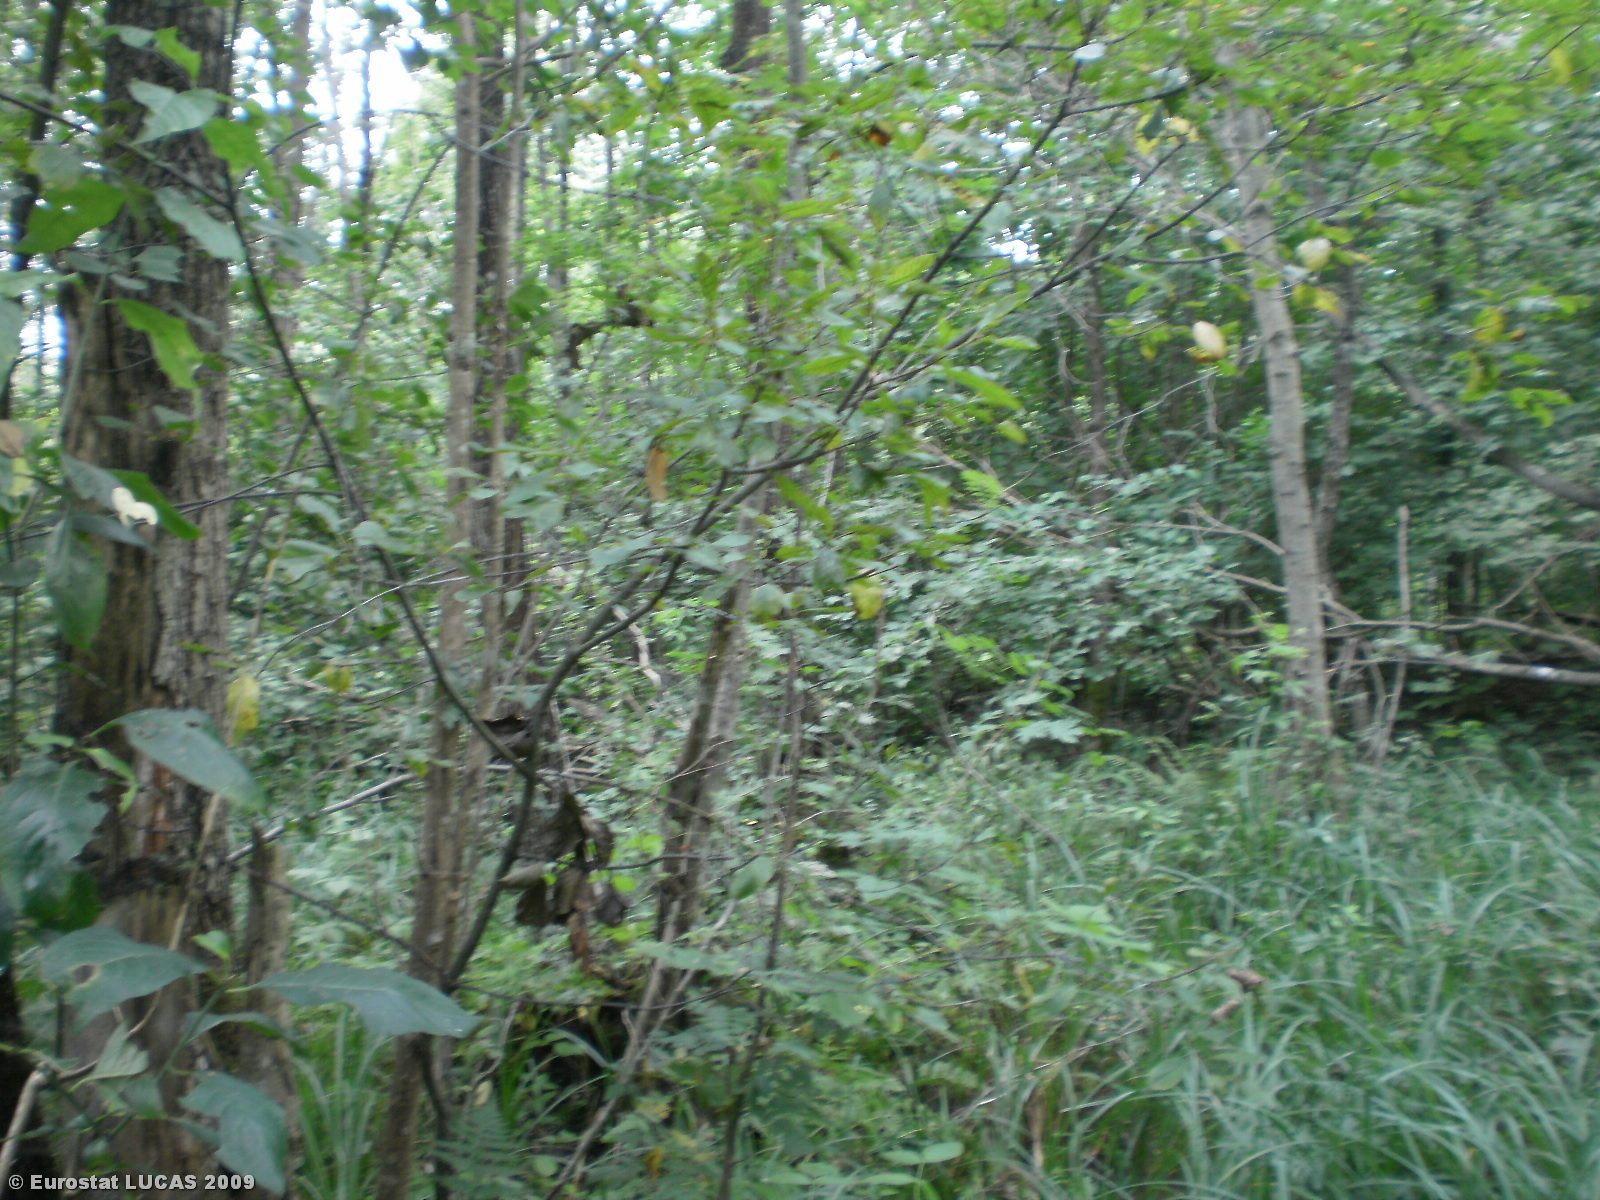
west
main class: Woodland
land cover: Broadleaved woodland
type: mire and swamp forests
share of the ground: > 75 %
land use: Forestry
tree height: > 5 m
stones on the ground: < 10 %
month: August
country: LT
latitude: 55.1183
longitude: 25.5716
